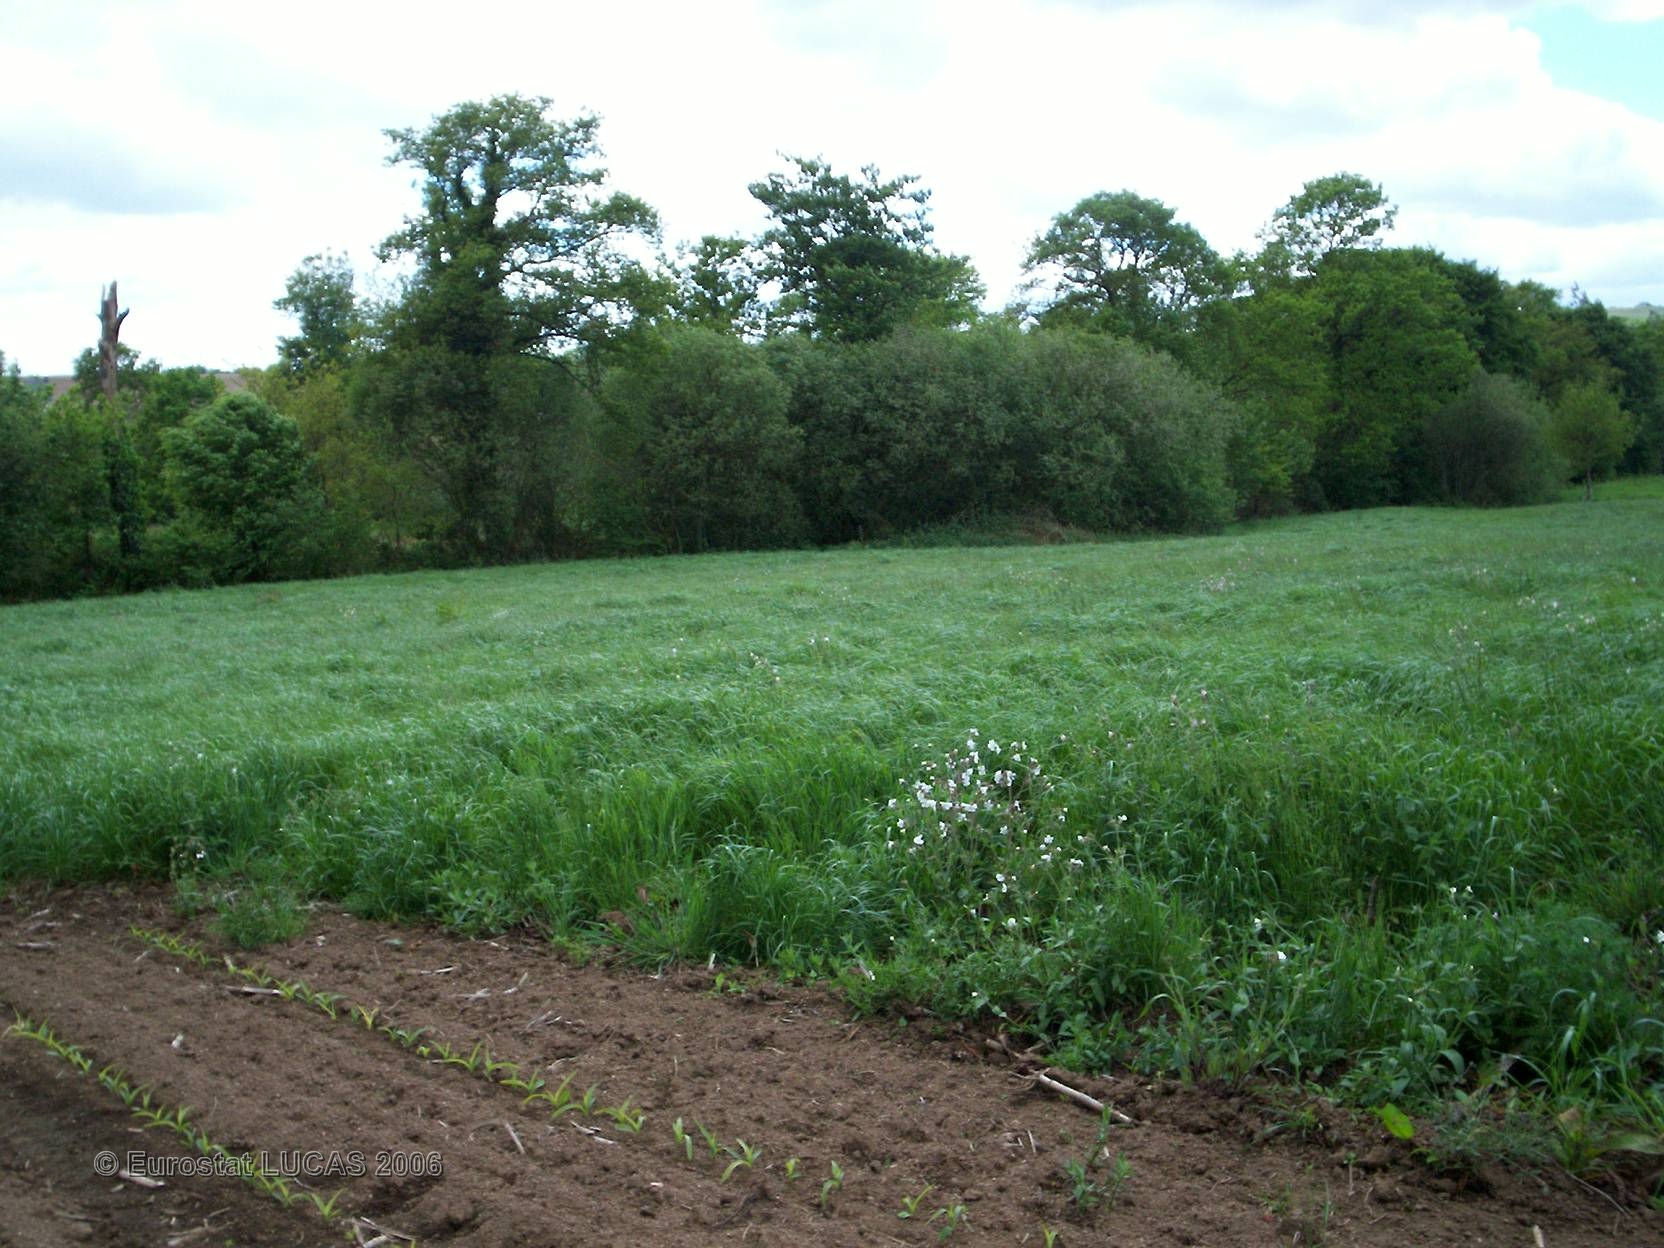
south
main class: Cropland
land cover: Maize
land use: Agriculture (excluding fallow land and kitchen gardens)
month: May
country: FR
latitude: 48.3948
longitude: -3.0220
